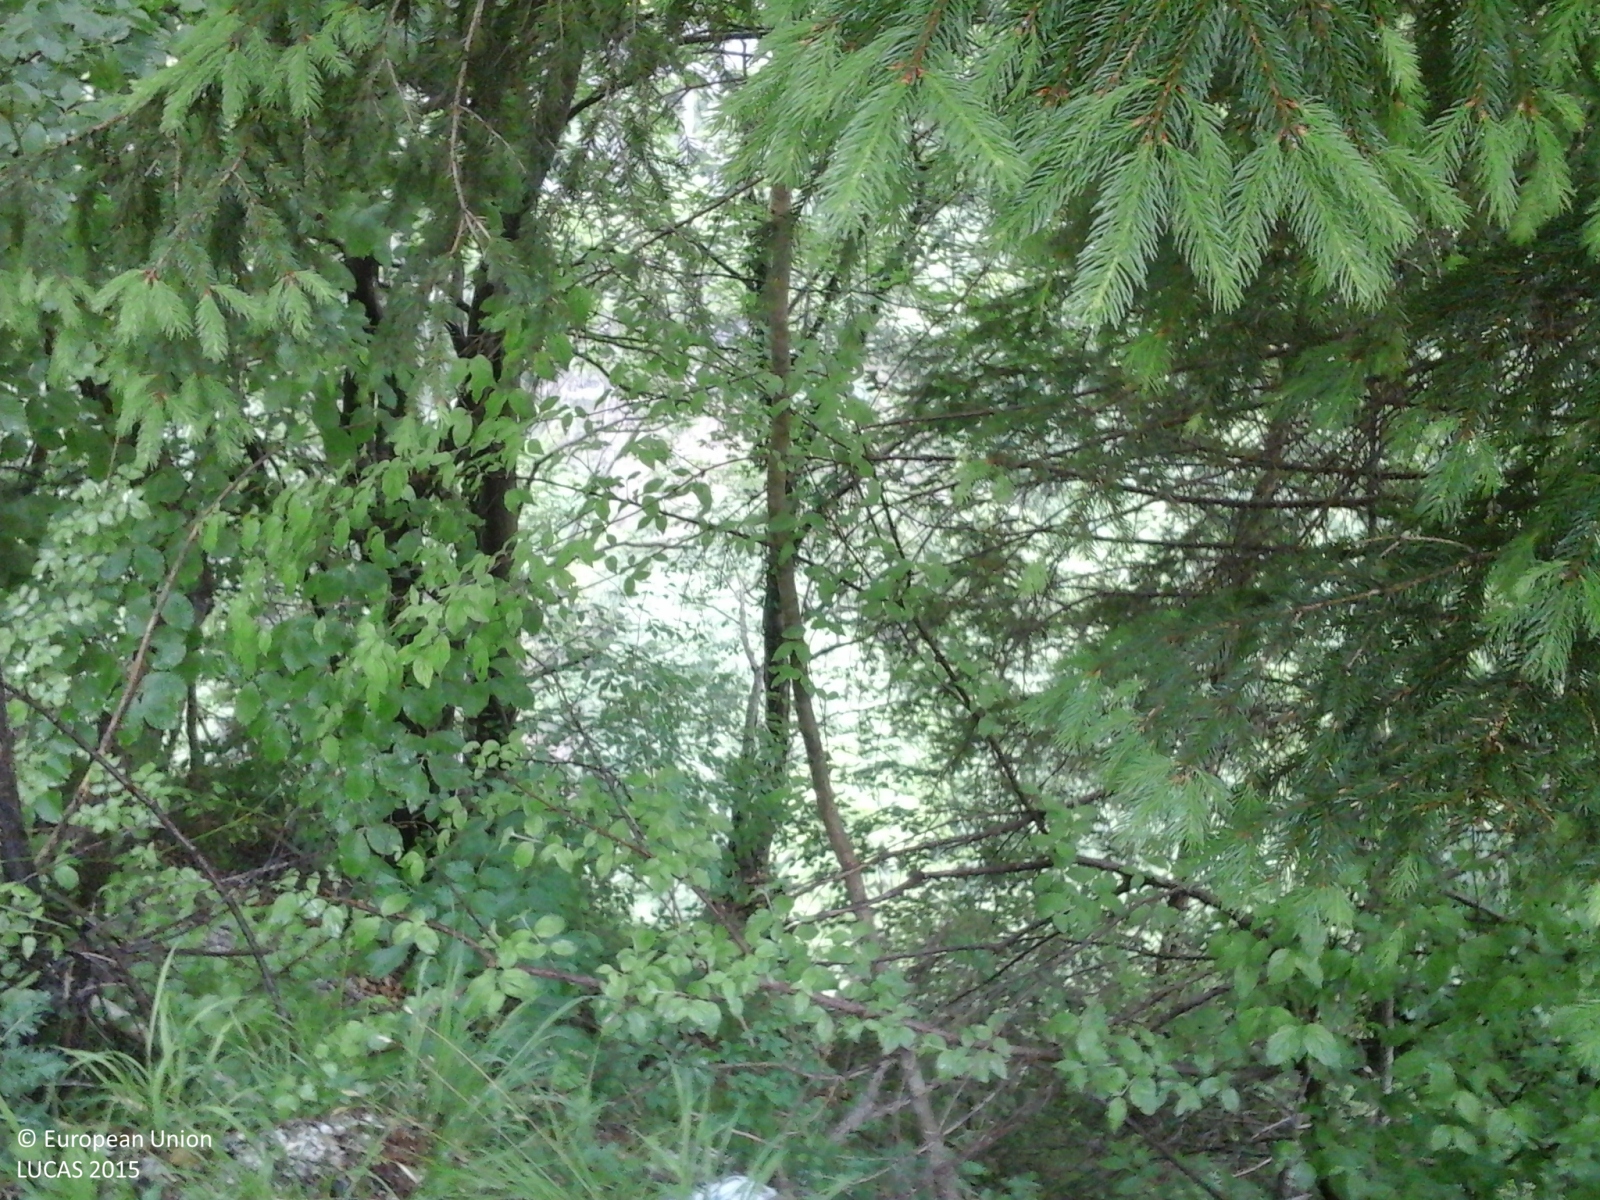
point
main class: Woodland
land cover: Broadleaved woodland
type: thermophilous deciduous forest
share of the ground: > 75 %
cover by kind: broadleaved forest trees 100 %
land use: Forestry
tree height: > 5 m
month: May
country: IT
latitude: 46.1023
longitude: 11.7699
